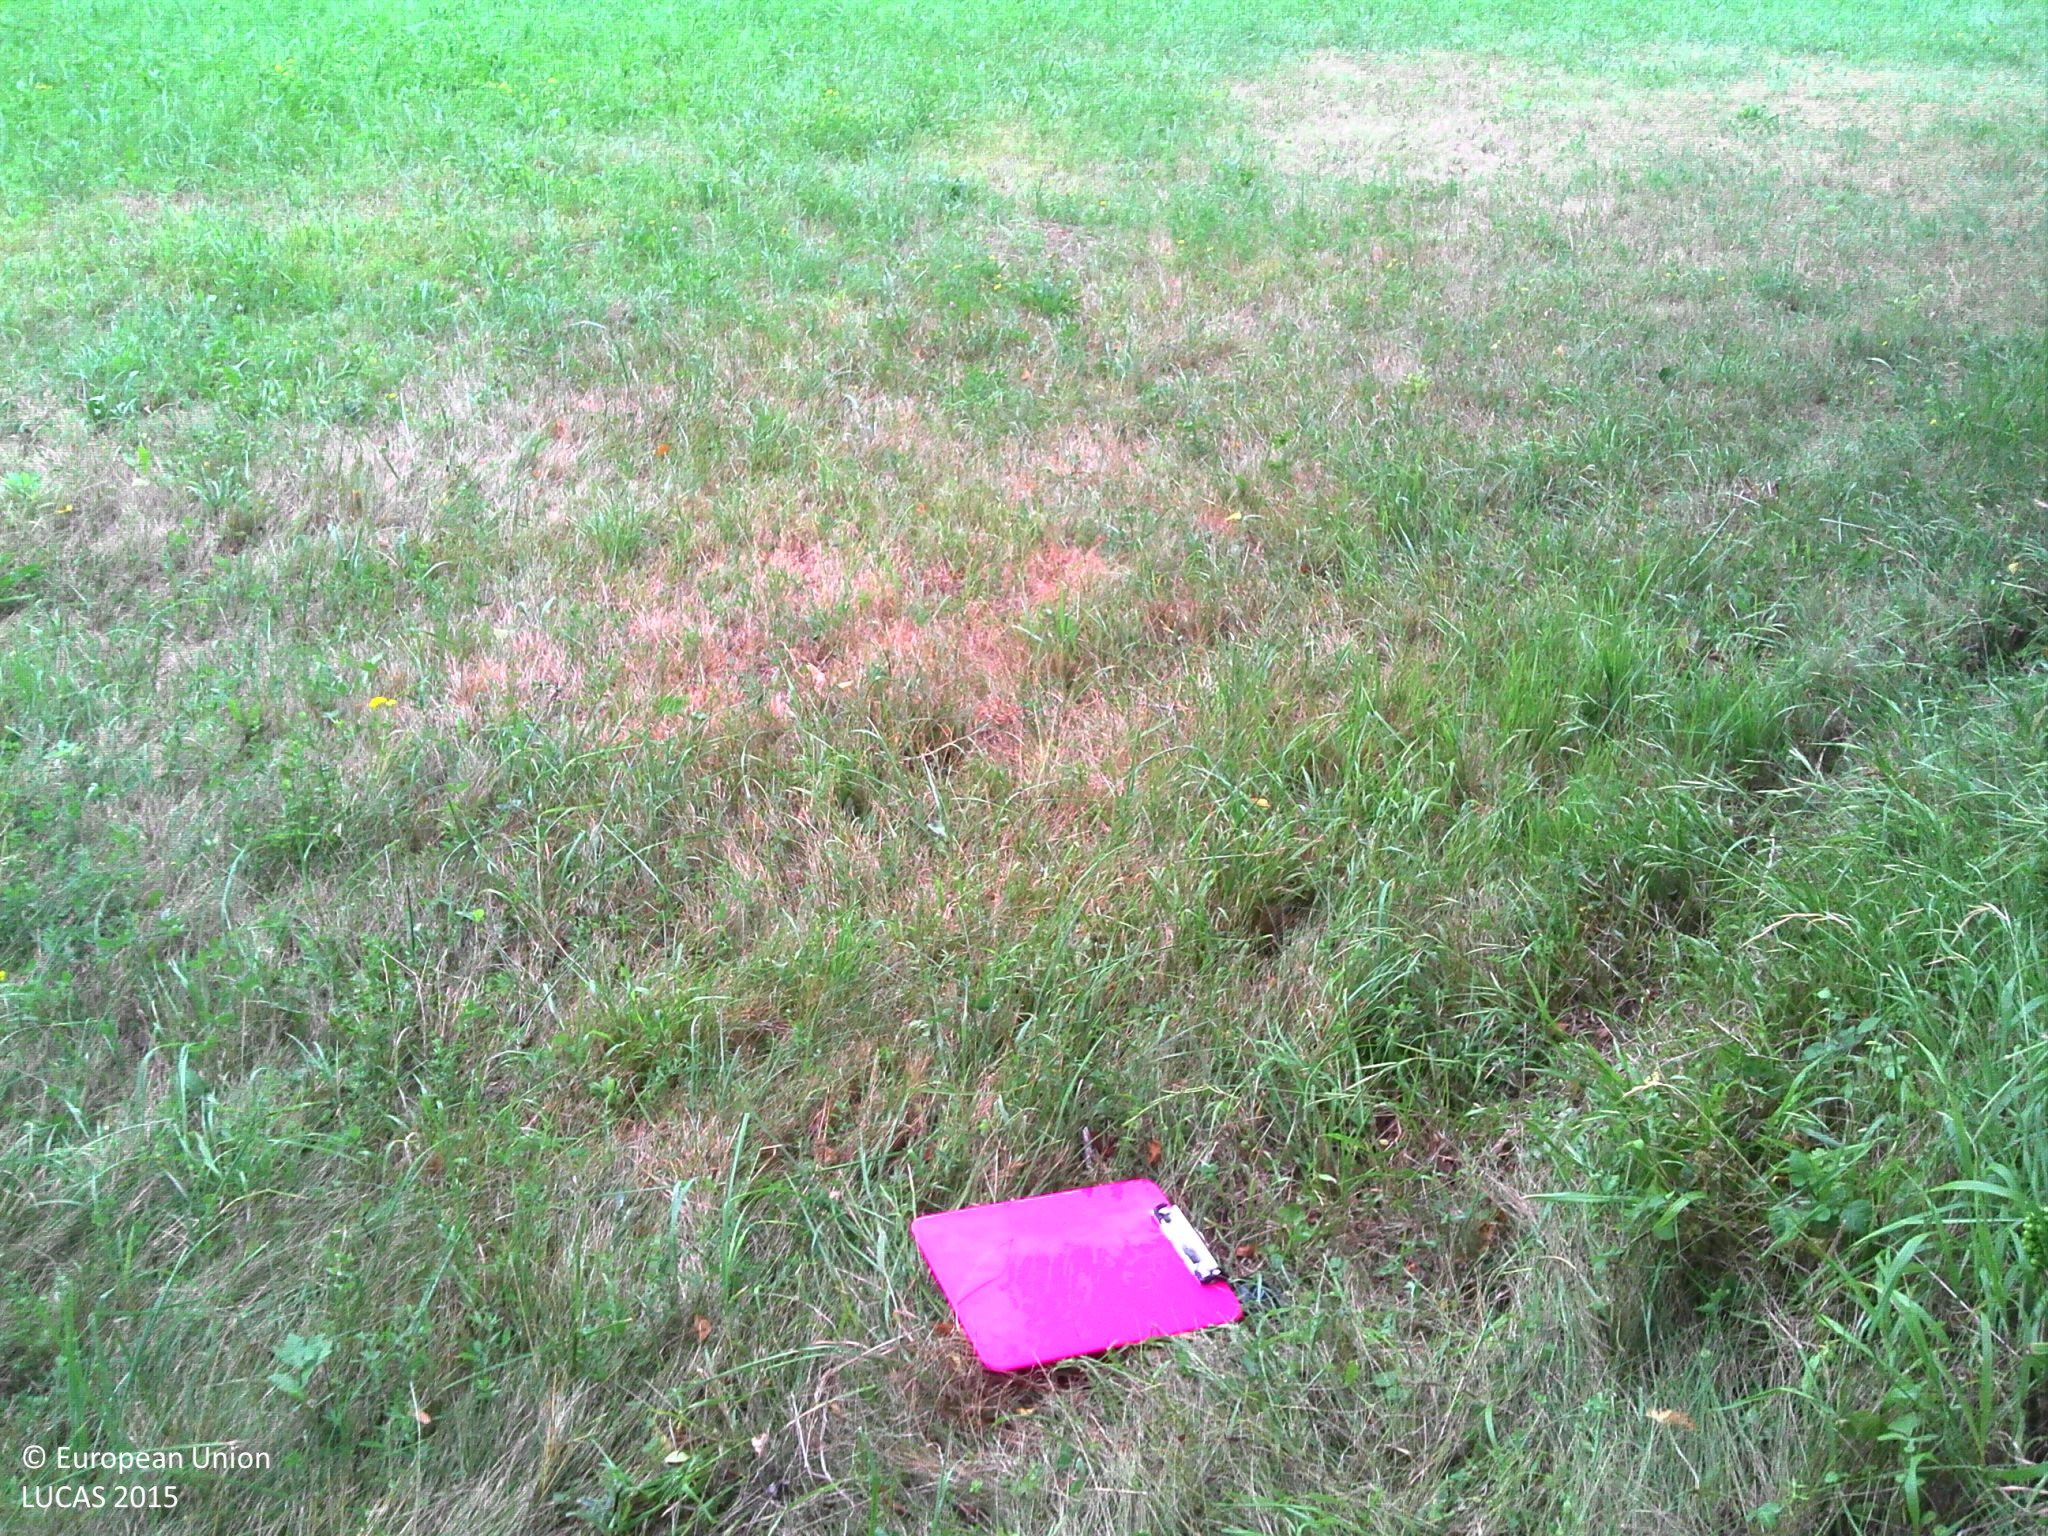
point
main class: Cropland
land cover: Temporary grasslands
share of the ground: > 75 %
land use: Agriculture (excluding fallow land and kitchen gardens)
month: July
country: FR
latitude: 43.0340
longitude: 1.4266
